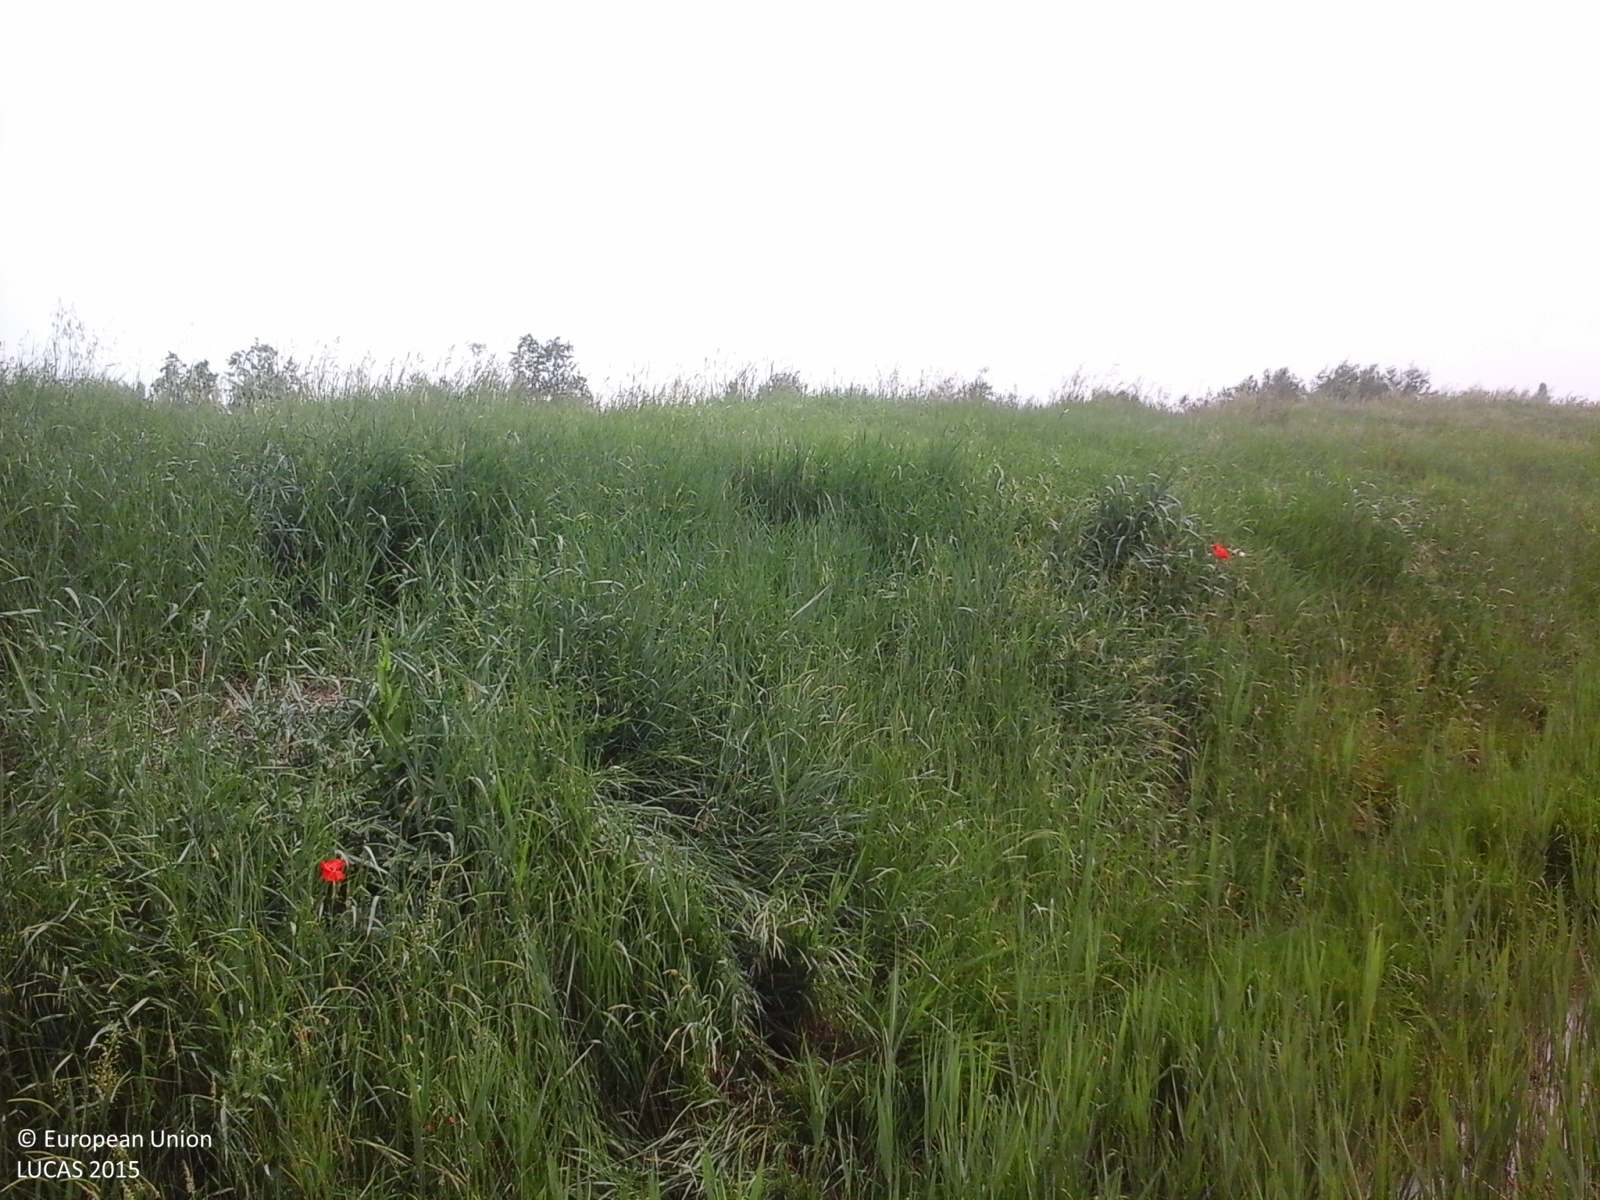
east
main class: Cropland
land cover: Durum wheat
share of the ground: > 75 %
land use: Agriculture (excluding fallow land and kitchen gardens)
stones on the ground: < 10 %
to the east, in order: Durum wheat; Ditches and canals; Grass margins; Paved roads, cycling and walking lanes; Grass margins; Ditches and canals; Grass margins; Spontaneously vegetated surfaces; Ditches and canals; Spontaneously vegetated surfaces; Shrubland with sparse tree cover; Spontaneously vegetated surfaces
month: May
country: IT
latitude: 44.9024
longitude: 11.2260
